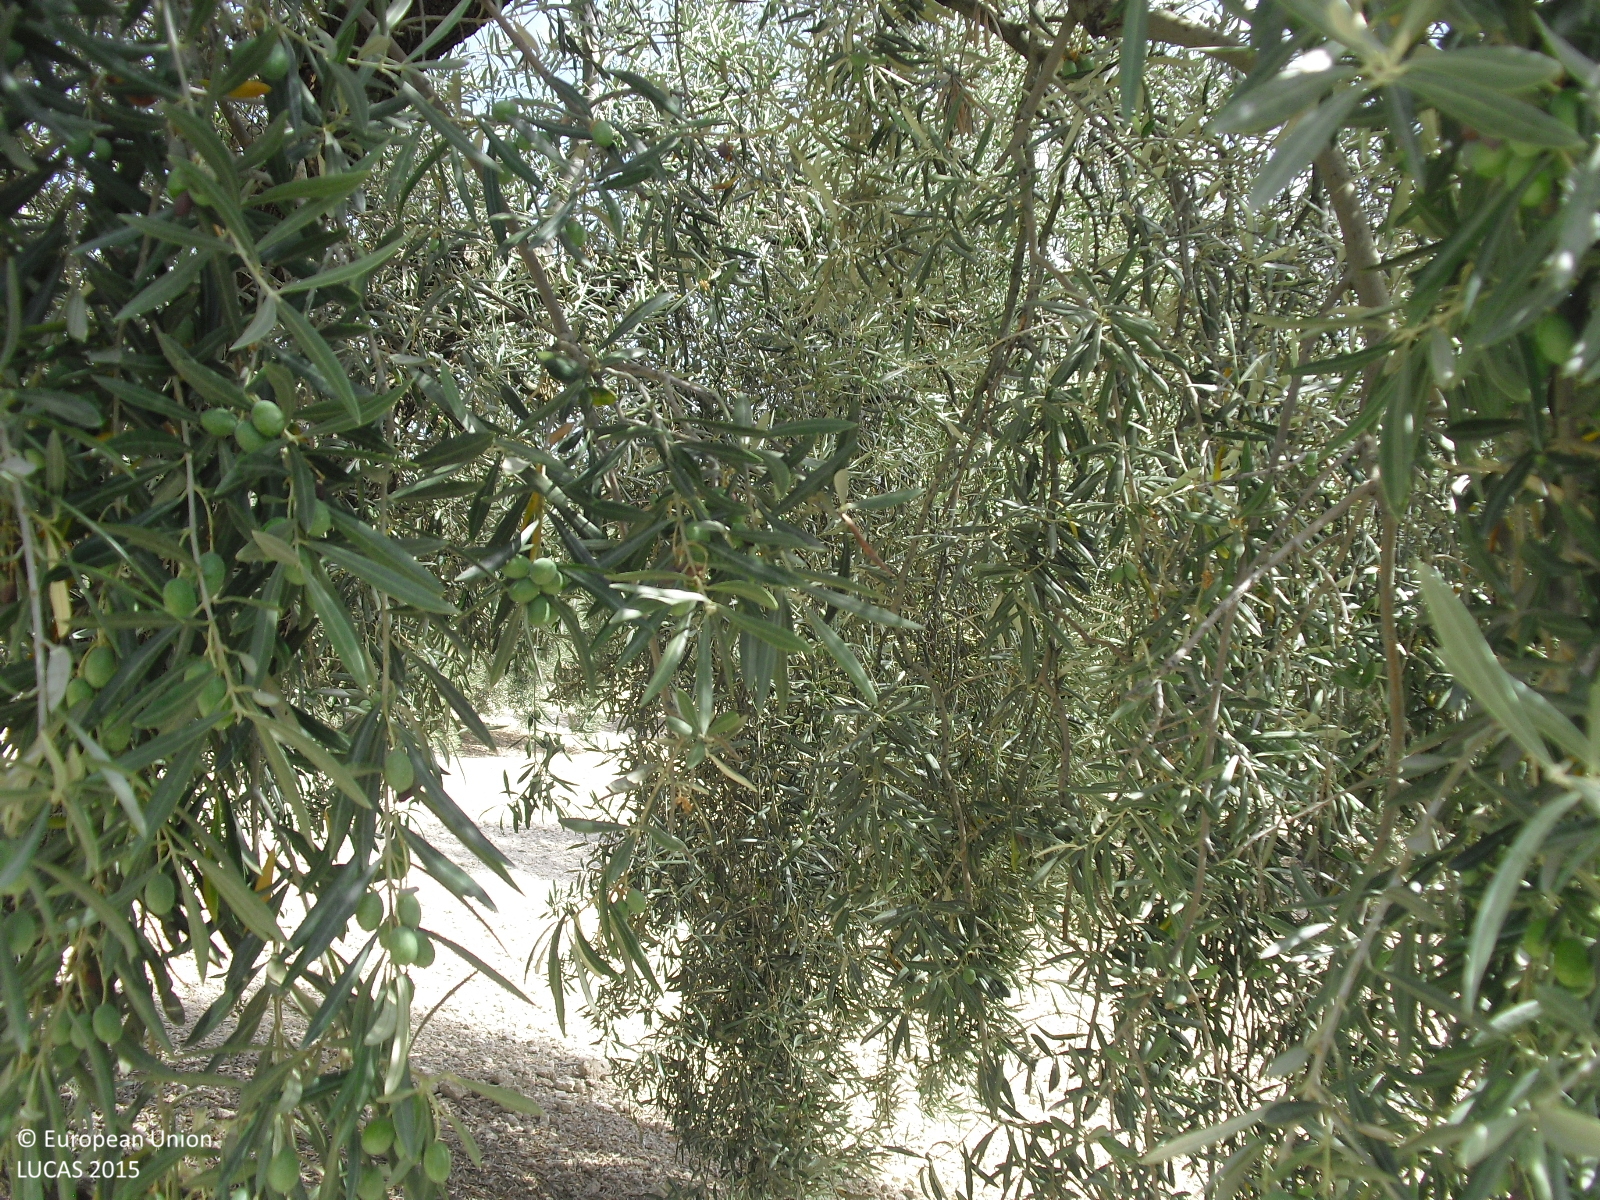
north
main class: Cropland
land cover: Olive groves
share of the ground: 25 - 50 %
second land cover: Other bare soil
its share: > 75 %
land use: Agriculture (excluding fallow land and kitchen gardens)
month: July
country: ES
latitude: 37.1602
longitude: -4.3997
